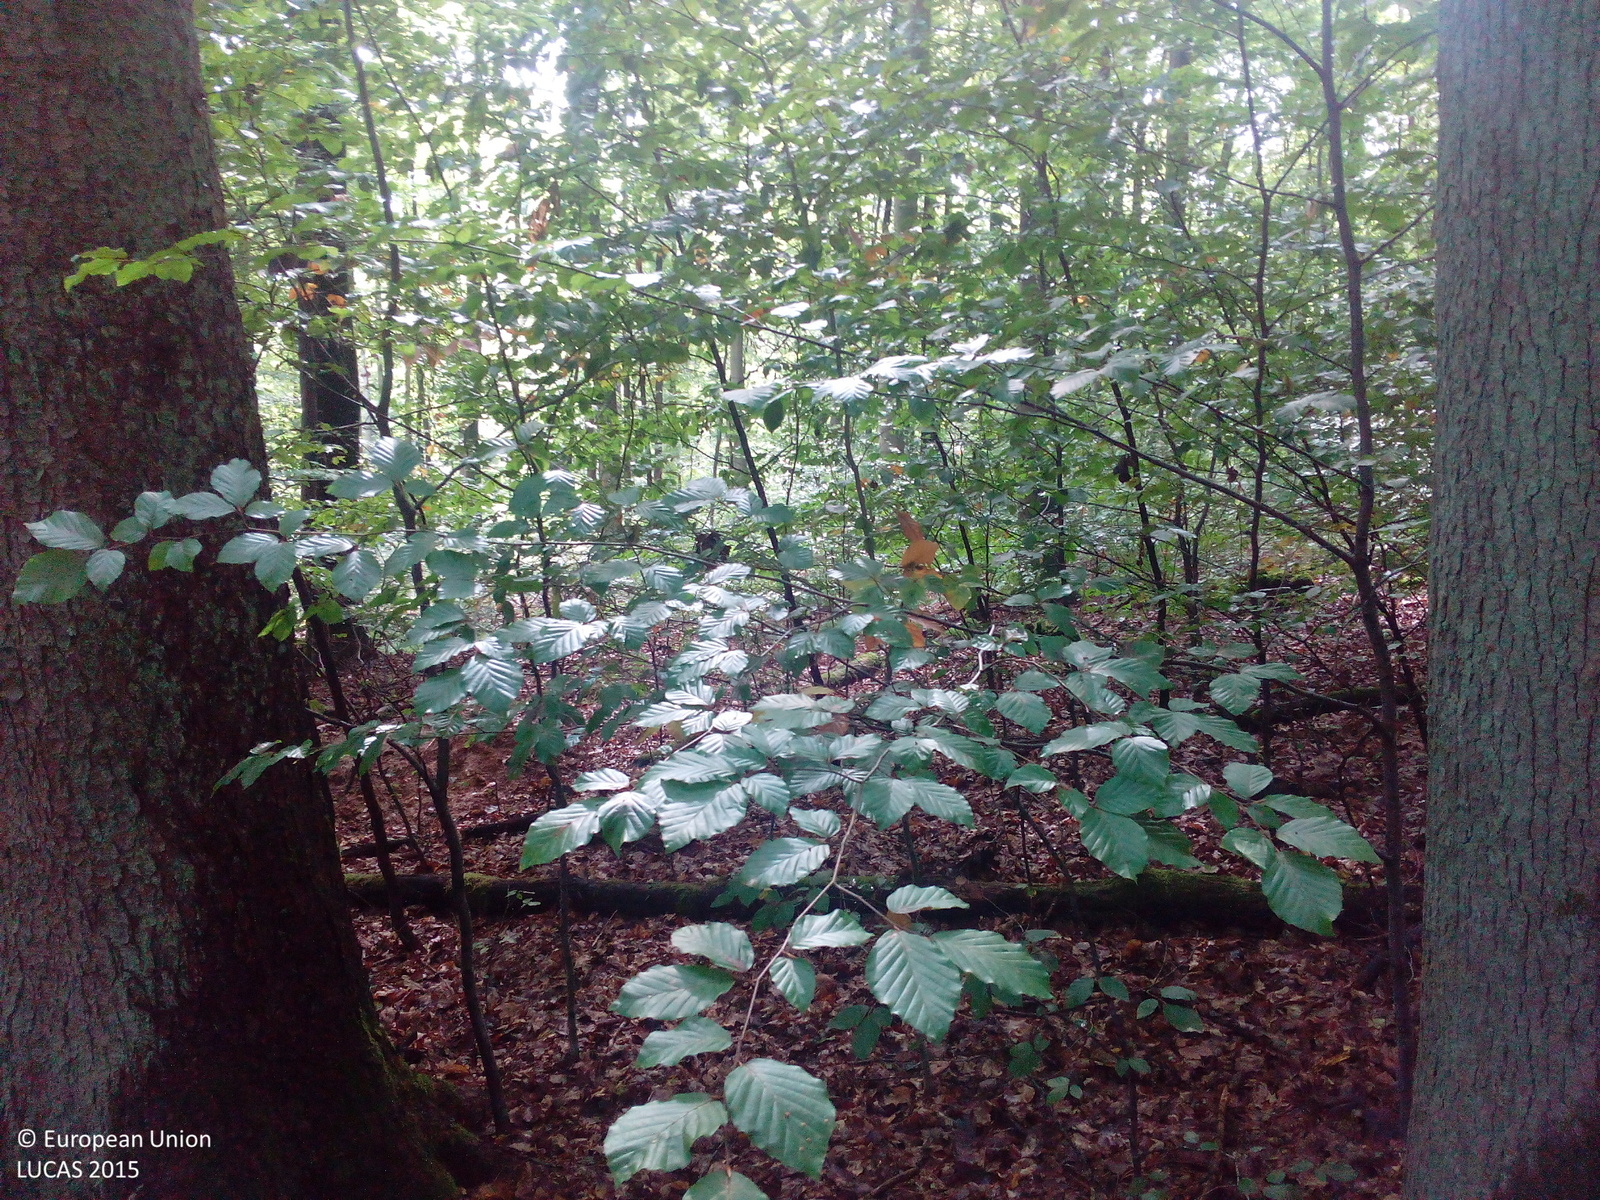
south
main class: Woodland
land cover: Broadleaved woodland
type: beech forest
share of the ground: > 75 %
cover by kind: broadleaved forest trees 85 %, coniferous forest trees 10 %, unconsolidated bare surface 5 %
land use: Forestry
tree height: > 5 m
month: September
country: DE
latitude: 49.8965
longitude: 9.9304
